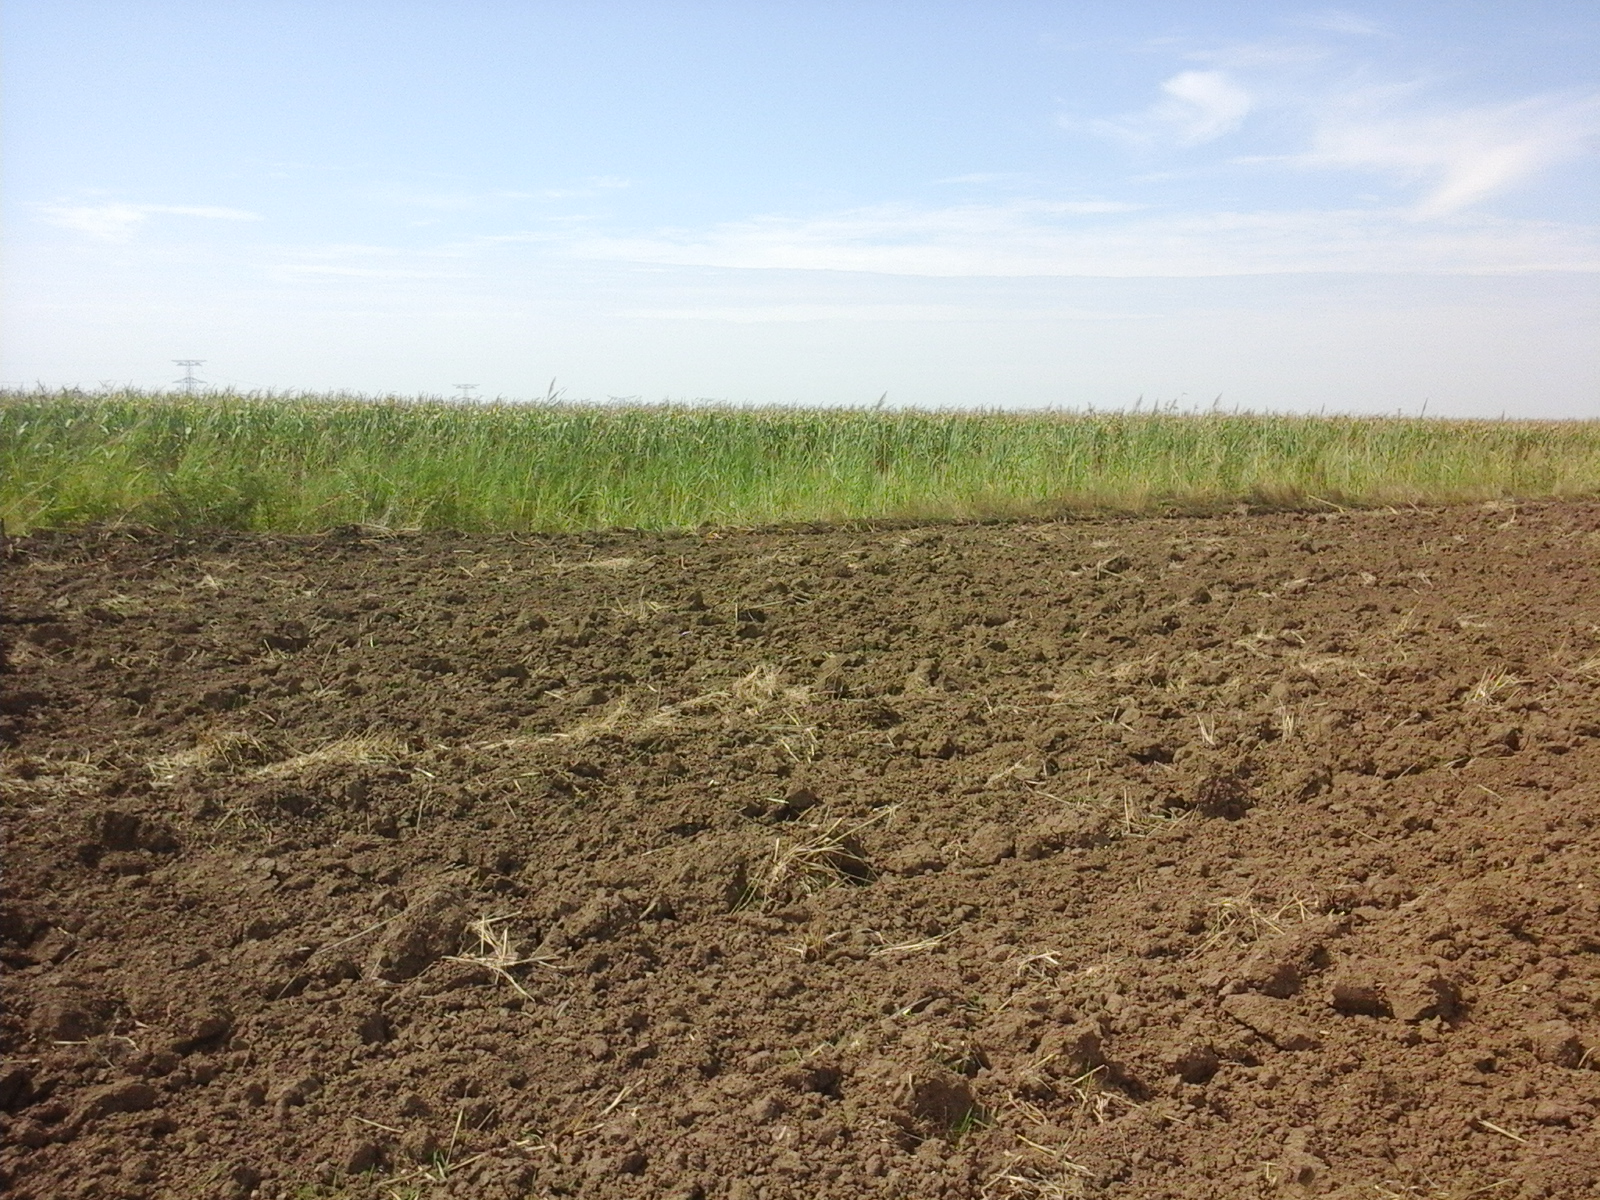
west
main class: Cropland
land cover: Common wheat
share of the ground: < 10 %
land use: Agriculture (excluding fallow land and kitchen gardens)
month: August
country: RO
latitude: 46.4813
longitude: 21.4345
